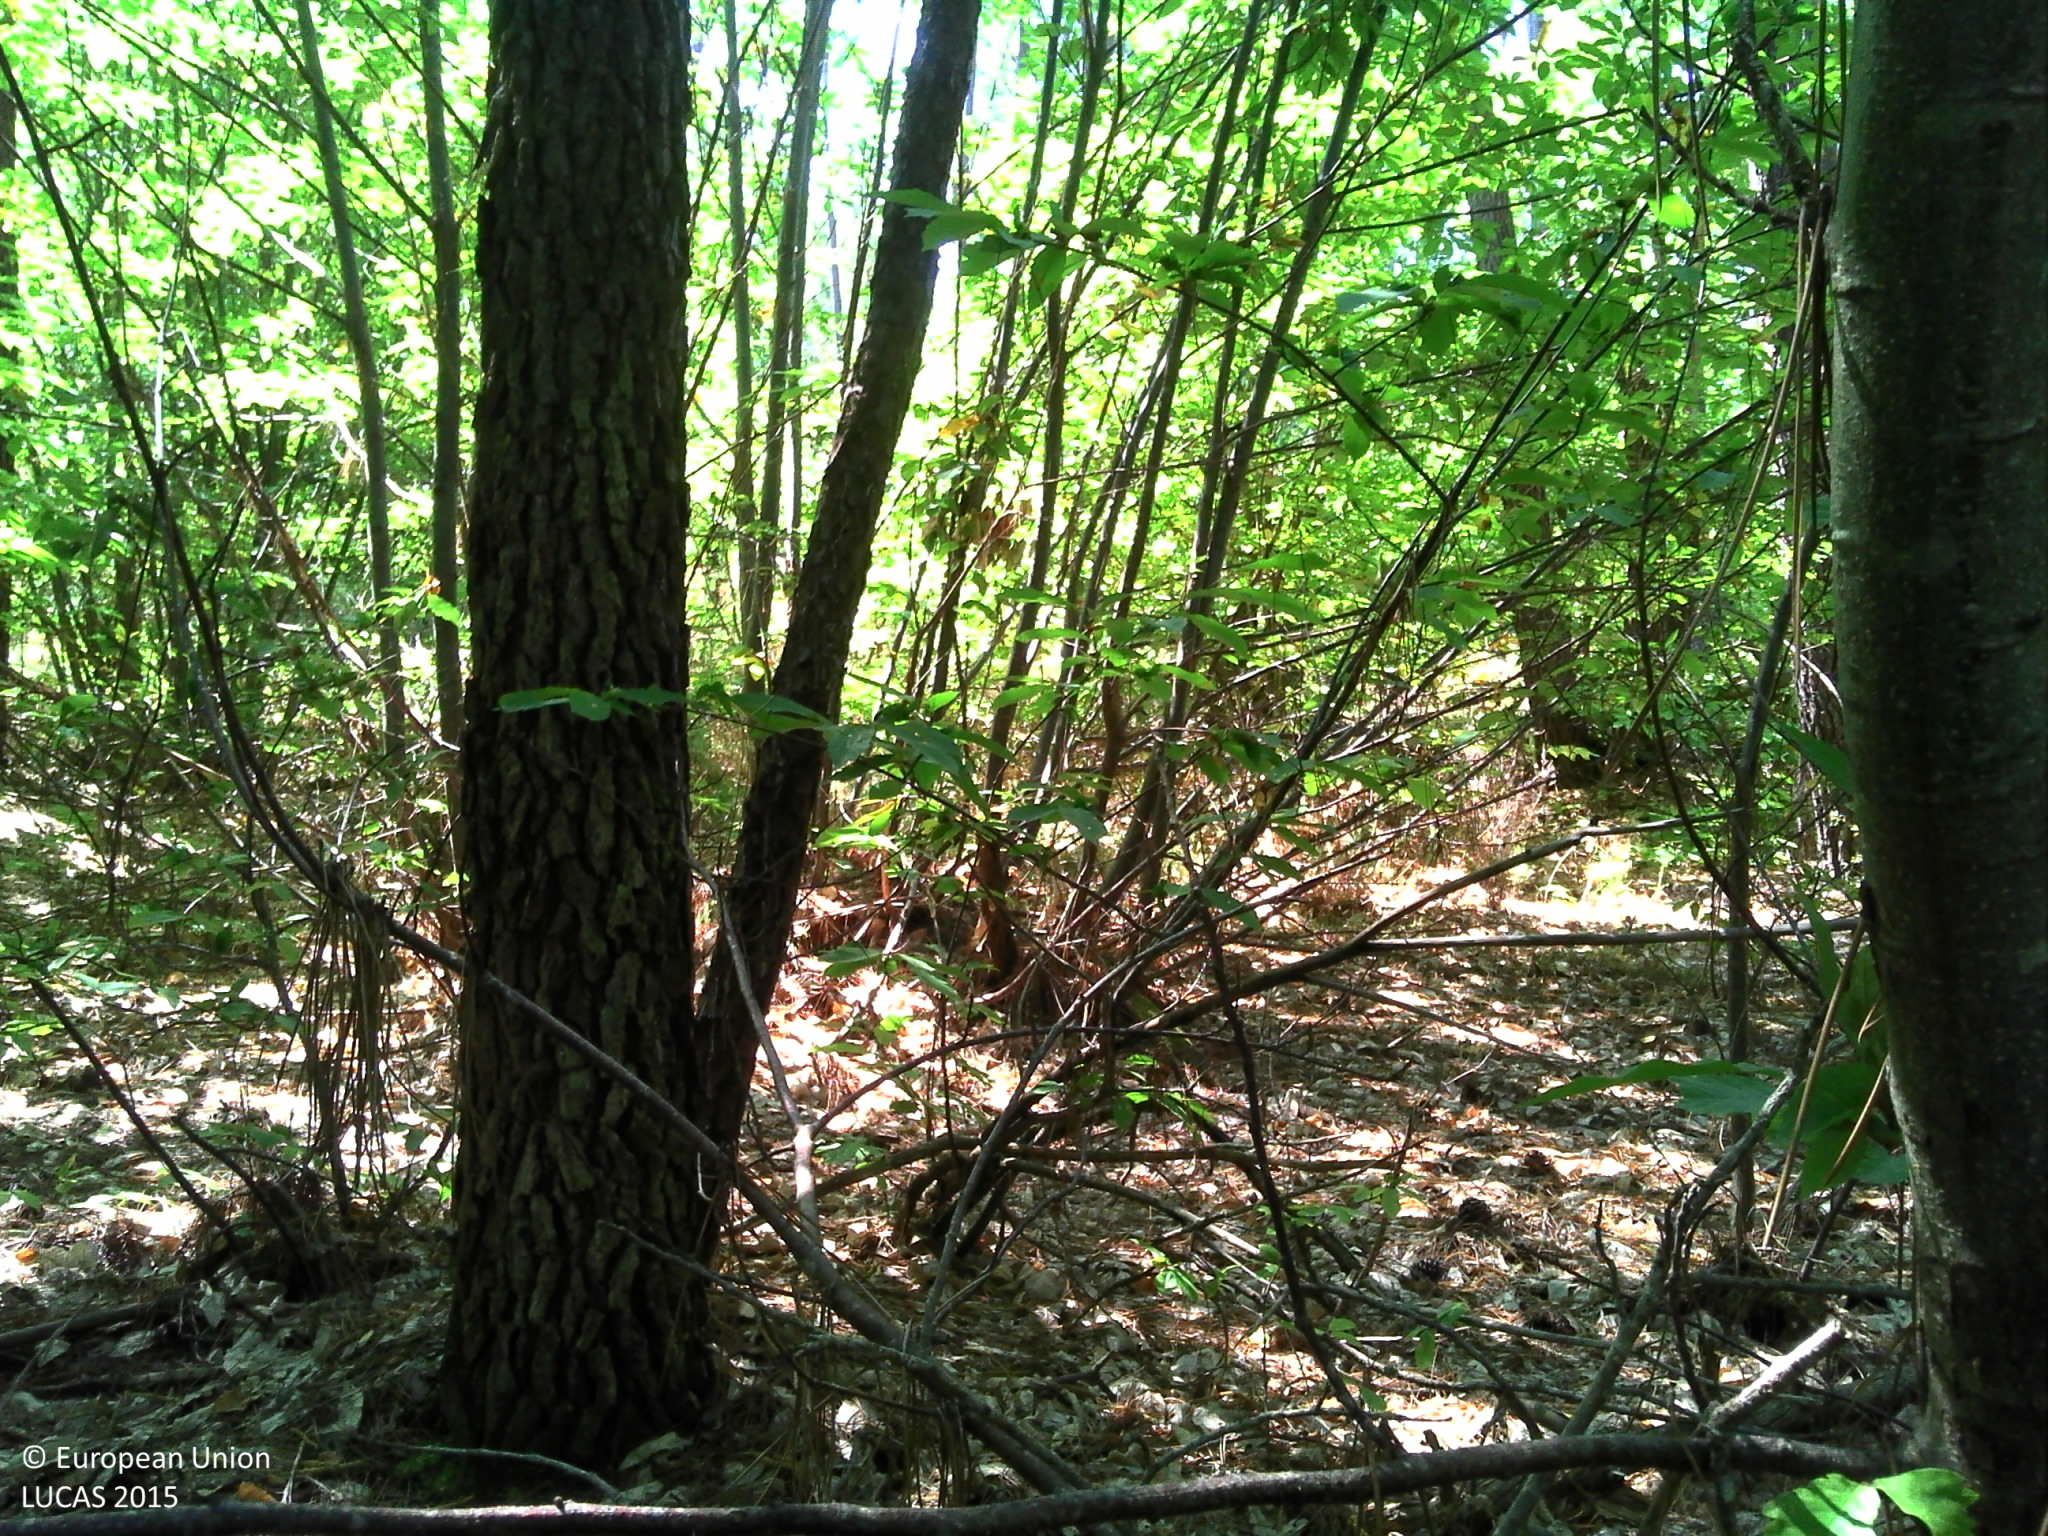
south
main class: Woodland
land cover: Broadleaved woodland
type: thermophilous deciduous forest
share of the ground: > 75 %
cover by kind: broadleaved forest trees 40 %, unconsolidated bare surface 20 %, coniferous forest trees 10 %, shrubs 10 %, herbaceous plants 10 %, lichens and mosses 10 %
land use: Forestry
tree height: > 5 m
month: July
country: FR
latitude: 45.0729
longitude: 0.4752
